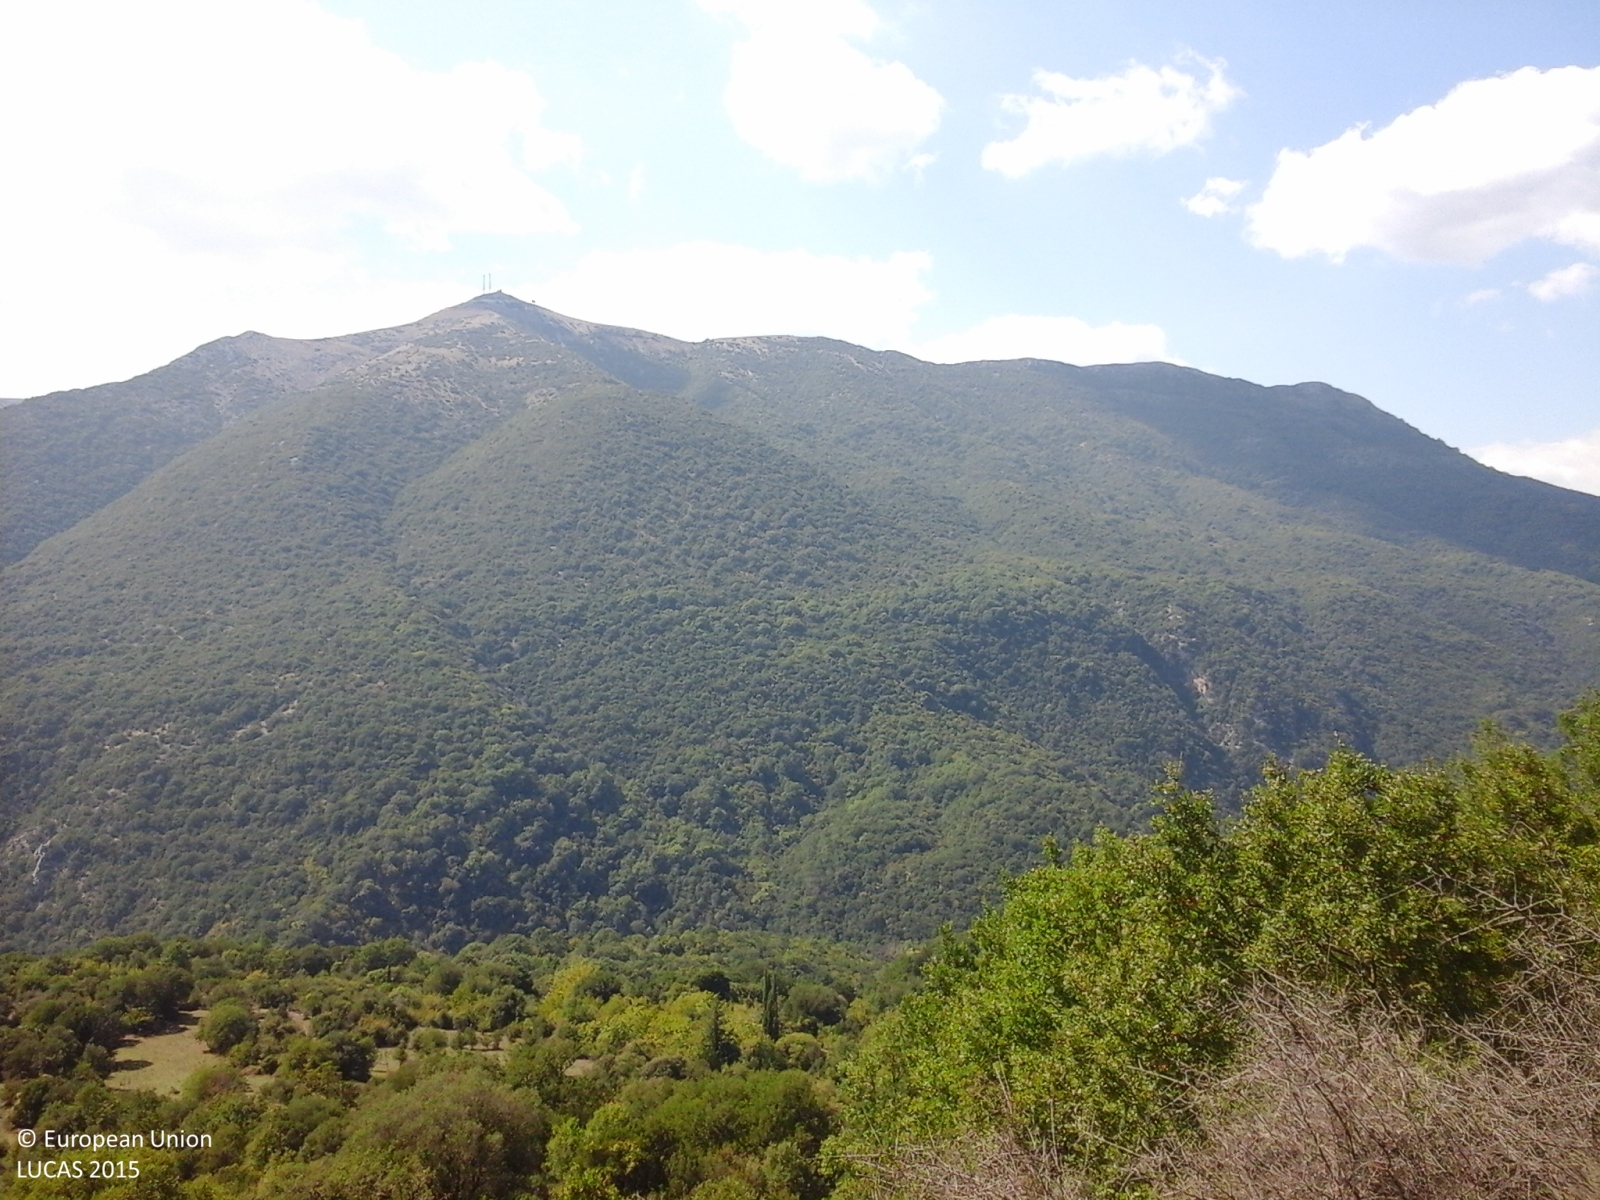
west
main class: Shrubland
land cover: Shrubland with sparse tree cover
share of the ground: > 75 %
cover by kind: shrubs 95 %, broadleaved forest trees 5 %
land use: Agriculture (excluding fallow land and kitchen gardens)
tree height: < 5 m
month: September
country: GR
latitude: 39.6297
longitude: 20.4967
